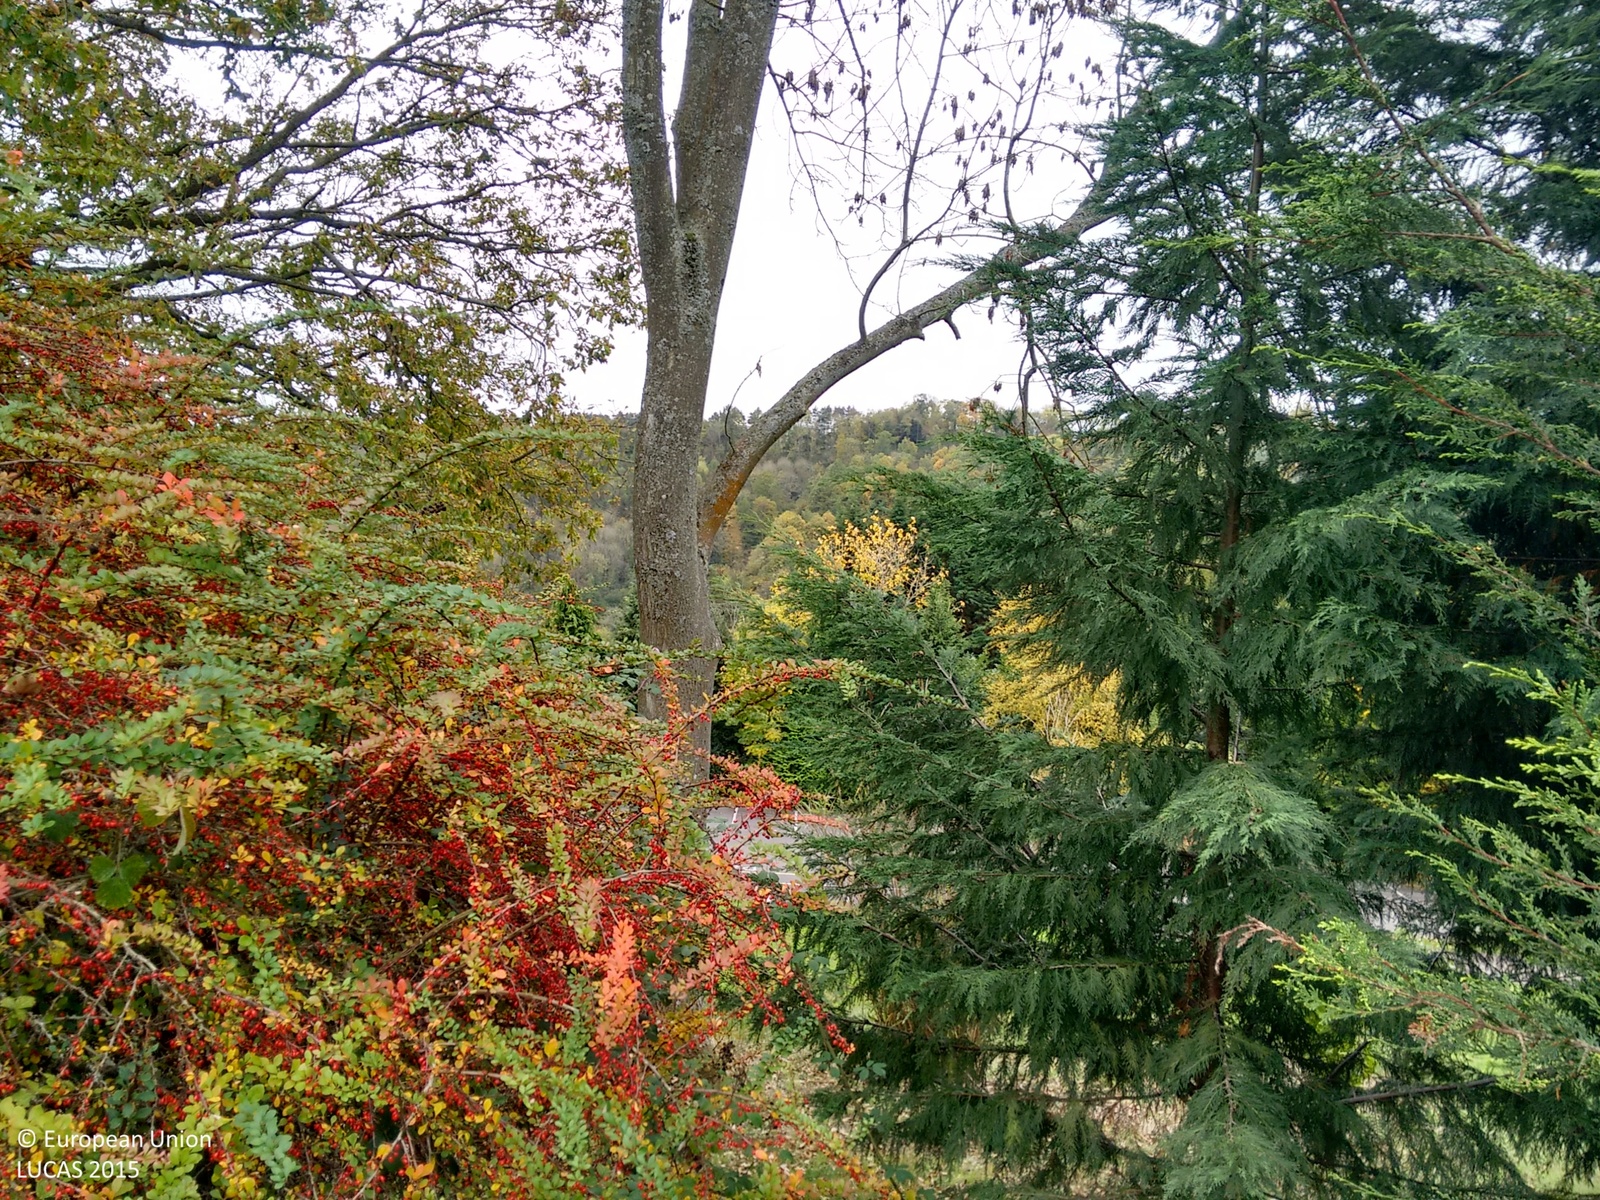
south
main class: Woodland
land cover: Other mixed woodland
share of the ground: > 75 %
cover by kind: broadleaved forest trees 40 %, coniferous forest trees 30 %, herbaceous plants 30 %
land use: Commerce
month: October
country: GB
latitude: 51.8665
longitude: -2.6011
